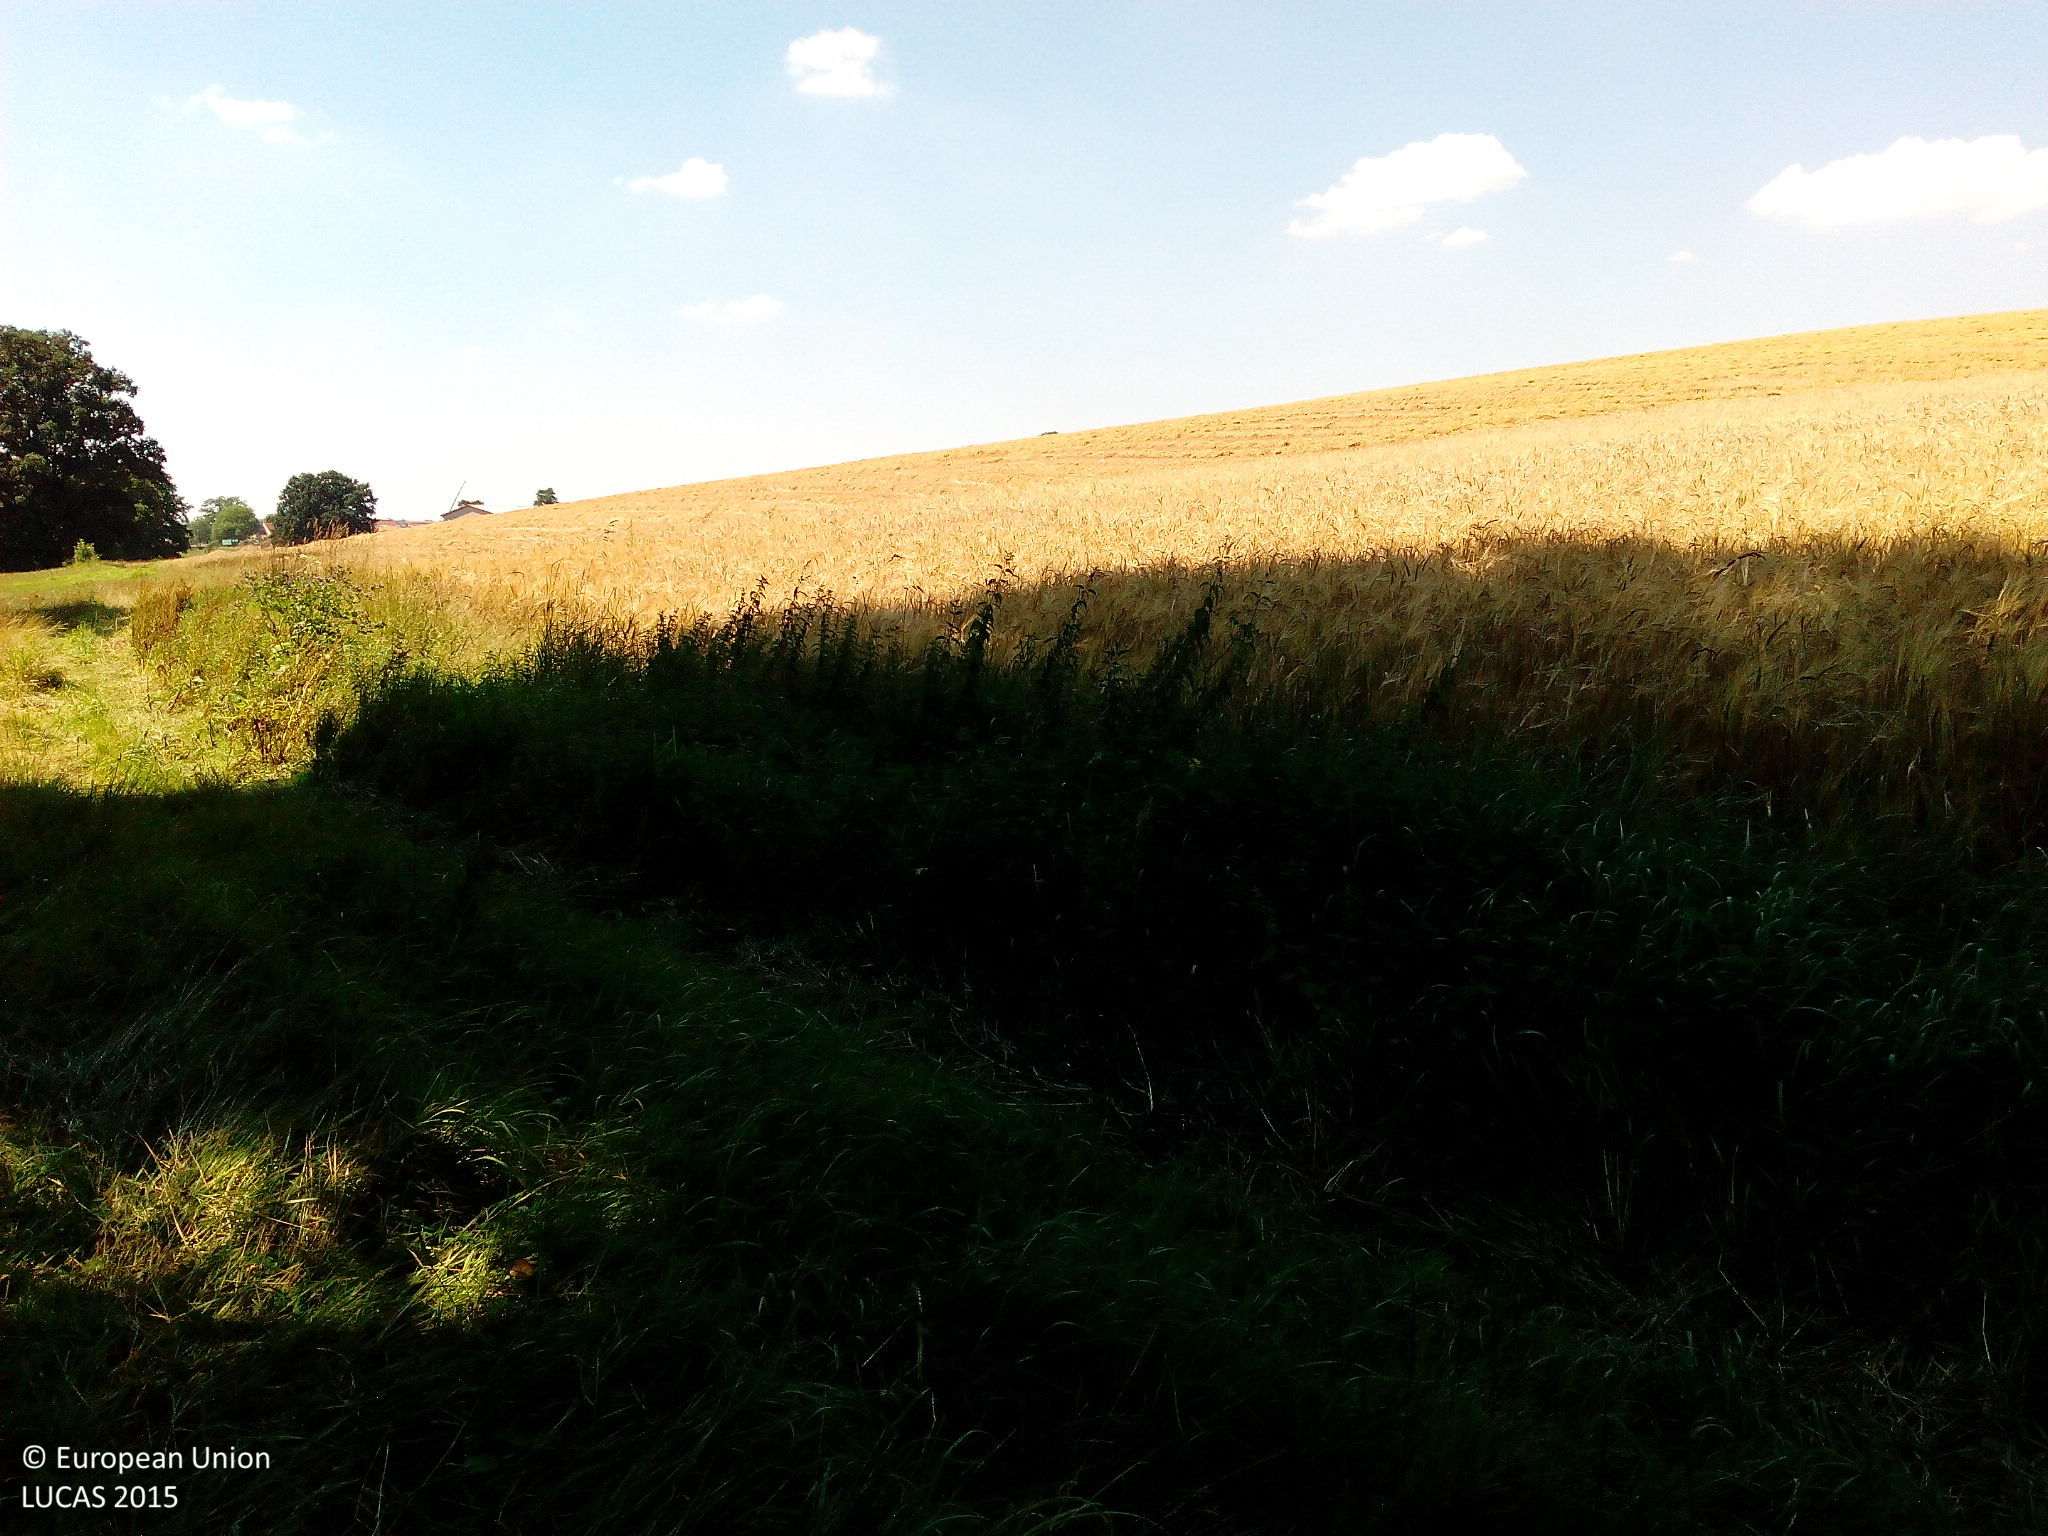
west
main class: Woodland
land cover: Broadleaved woodland
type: thermophilous deciduous forest
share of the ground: > 75 %
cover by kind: broadleaved forest trees 90 %, herbaceous plants 10 %
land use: Forestry
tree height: > 5 m
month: August
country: DE
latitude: 50.7575
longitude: 9.3056
